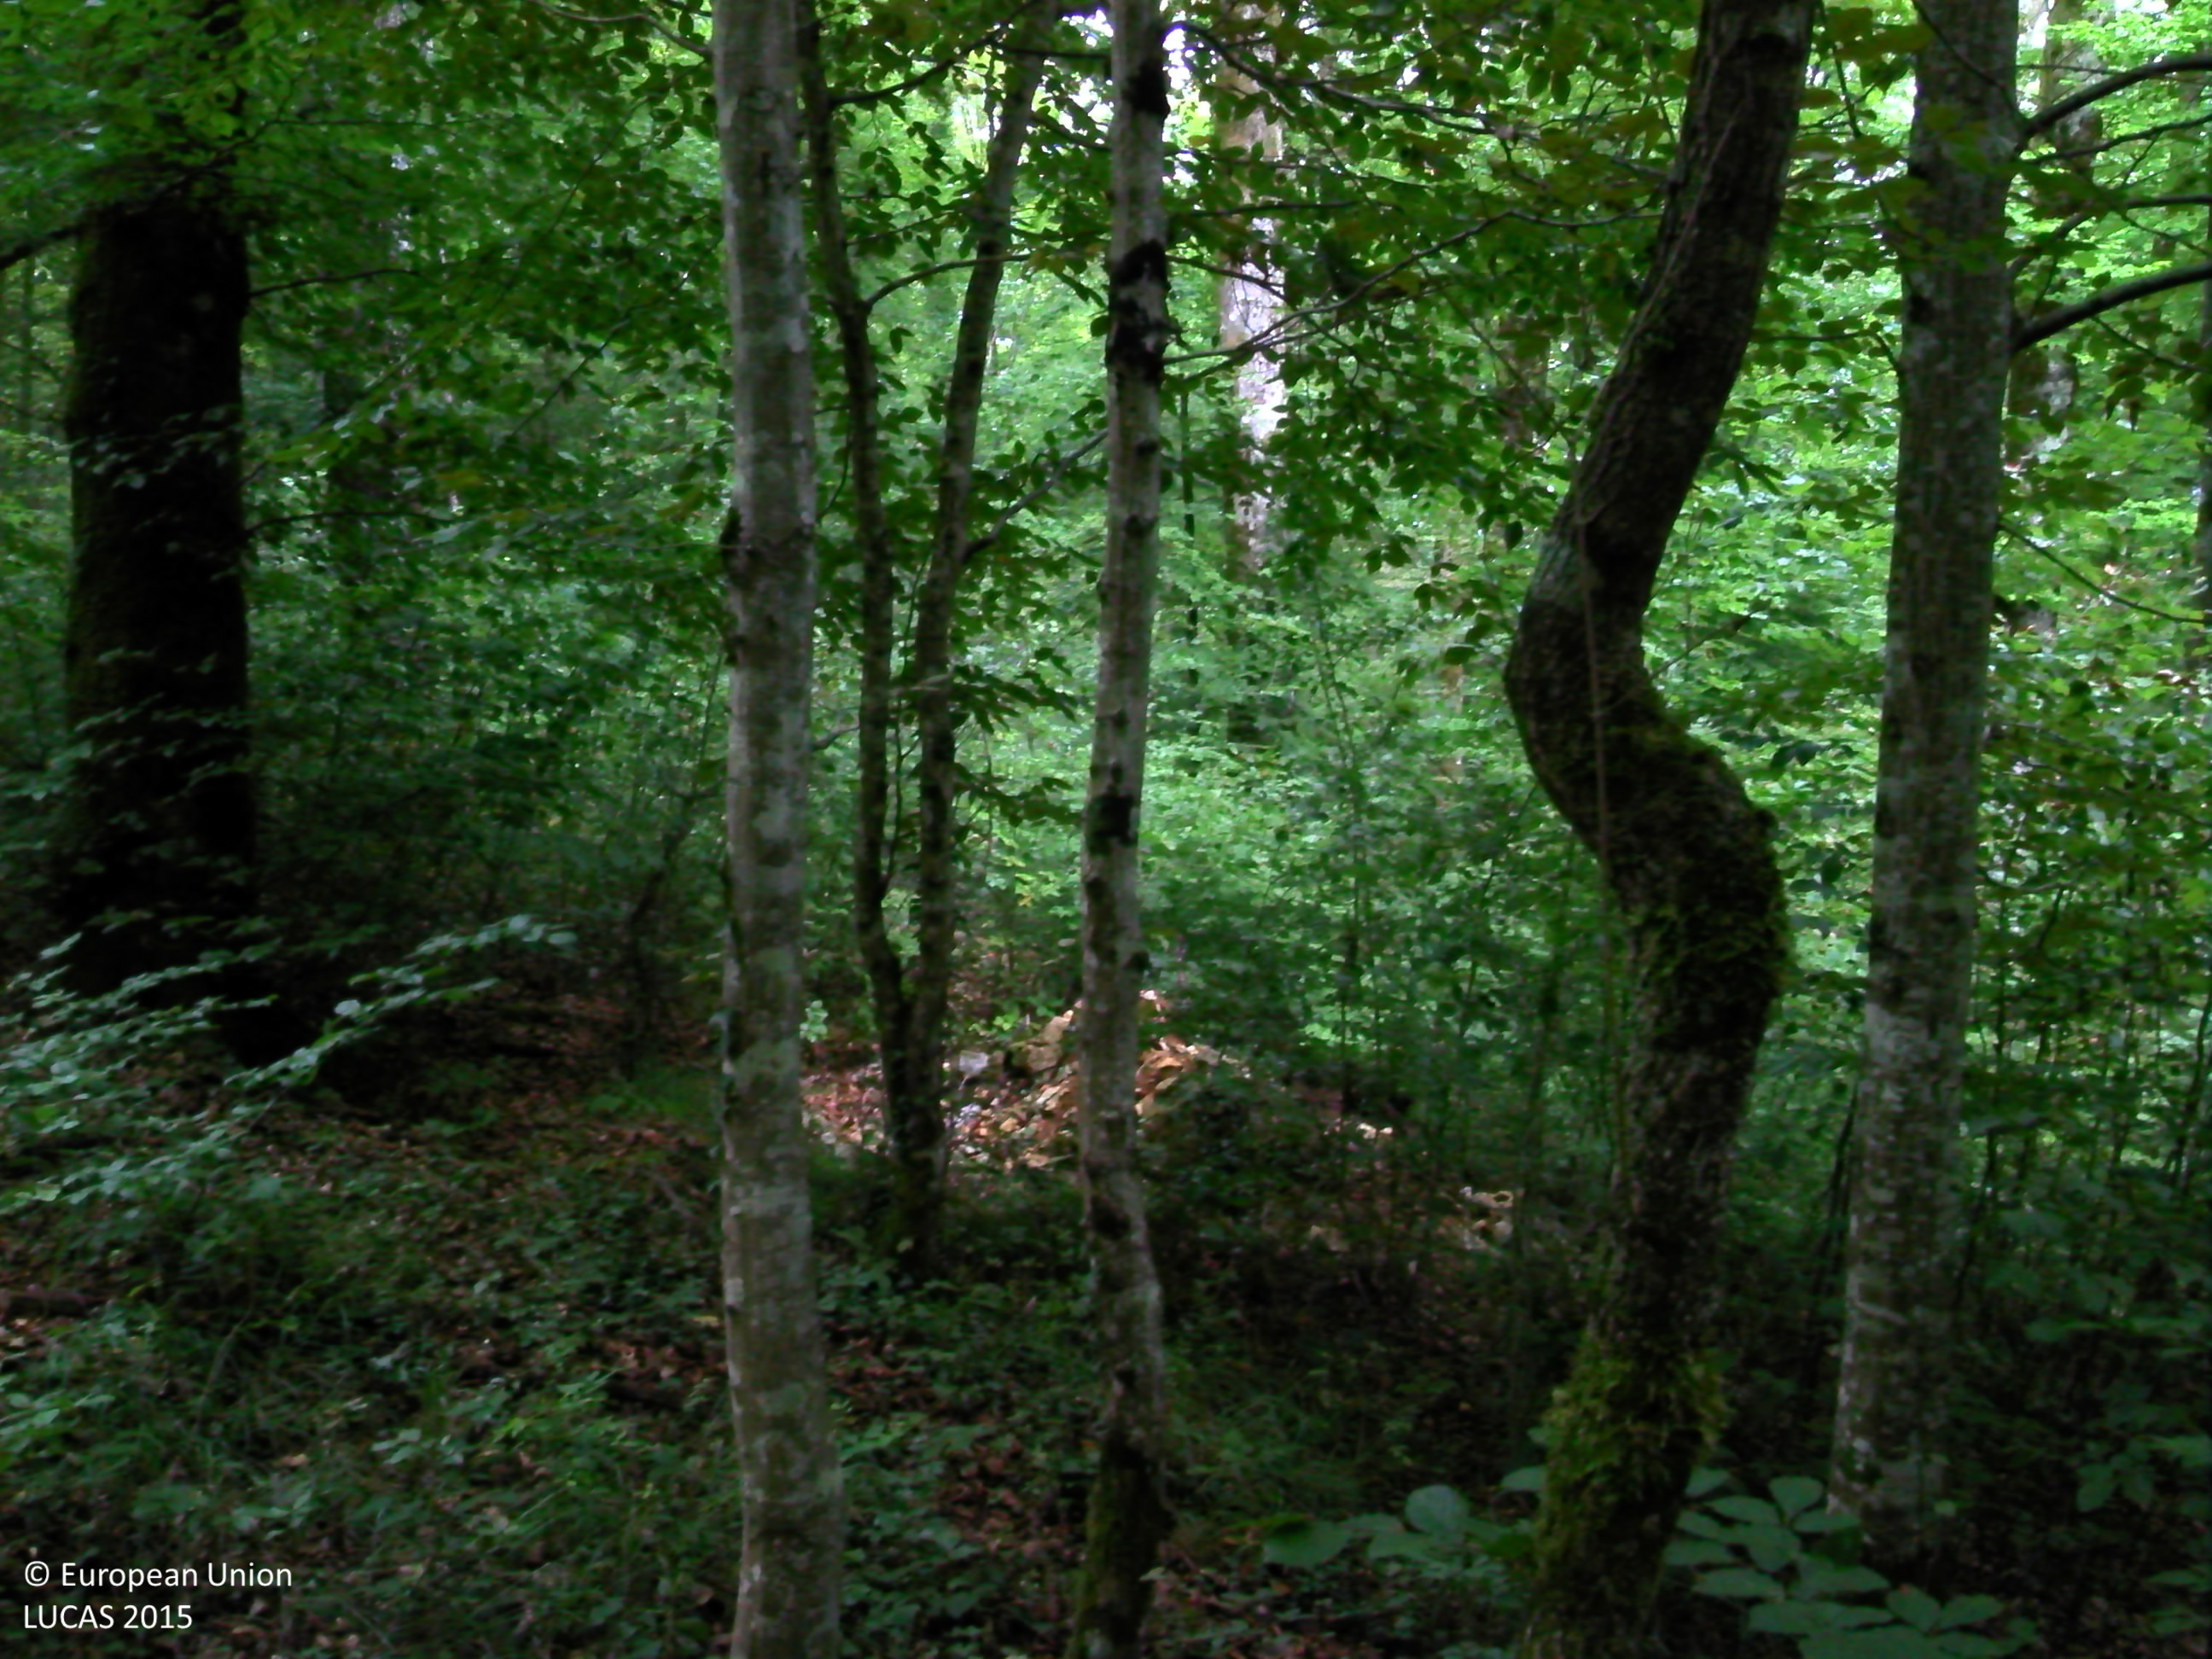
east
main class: Woodland
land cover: Broadleaved woodland
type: beech forest
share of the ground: > 75 %
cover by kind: broadleaved forest trees 85 %, herbaceous plants 10 %, shrubs 5 %
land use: Forestry
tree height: > 5 m
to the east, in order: Broadleaved woodland
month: September
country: FR
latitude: 48.1919
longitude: 4.8193
